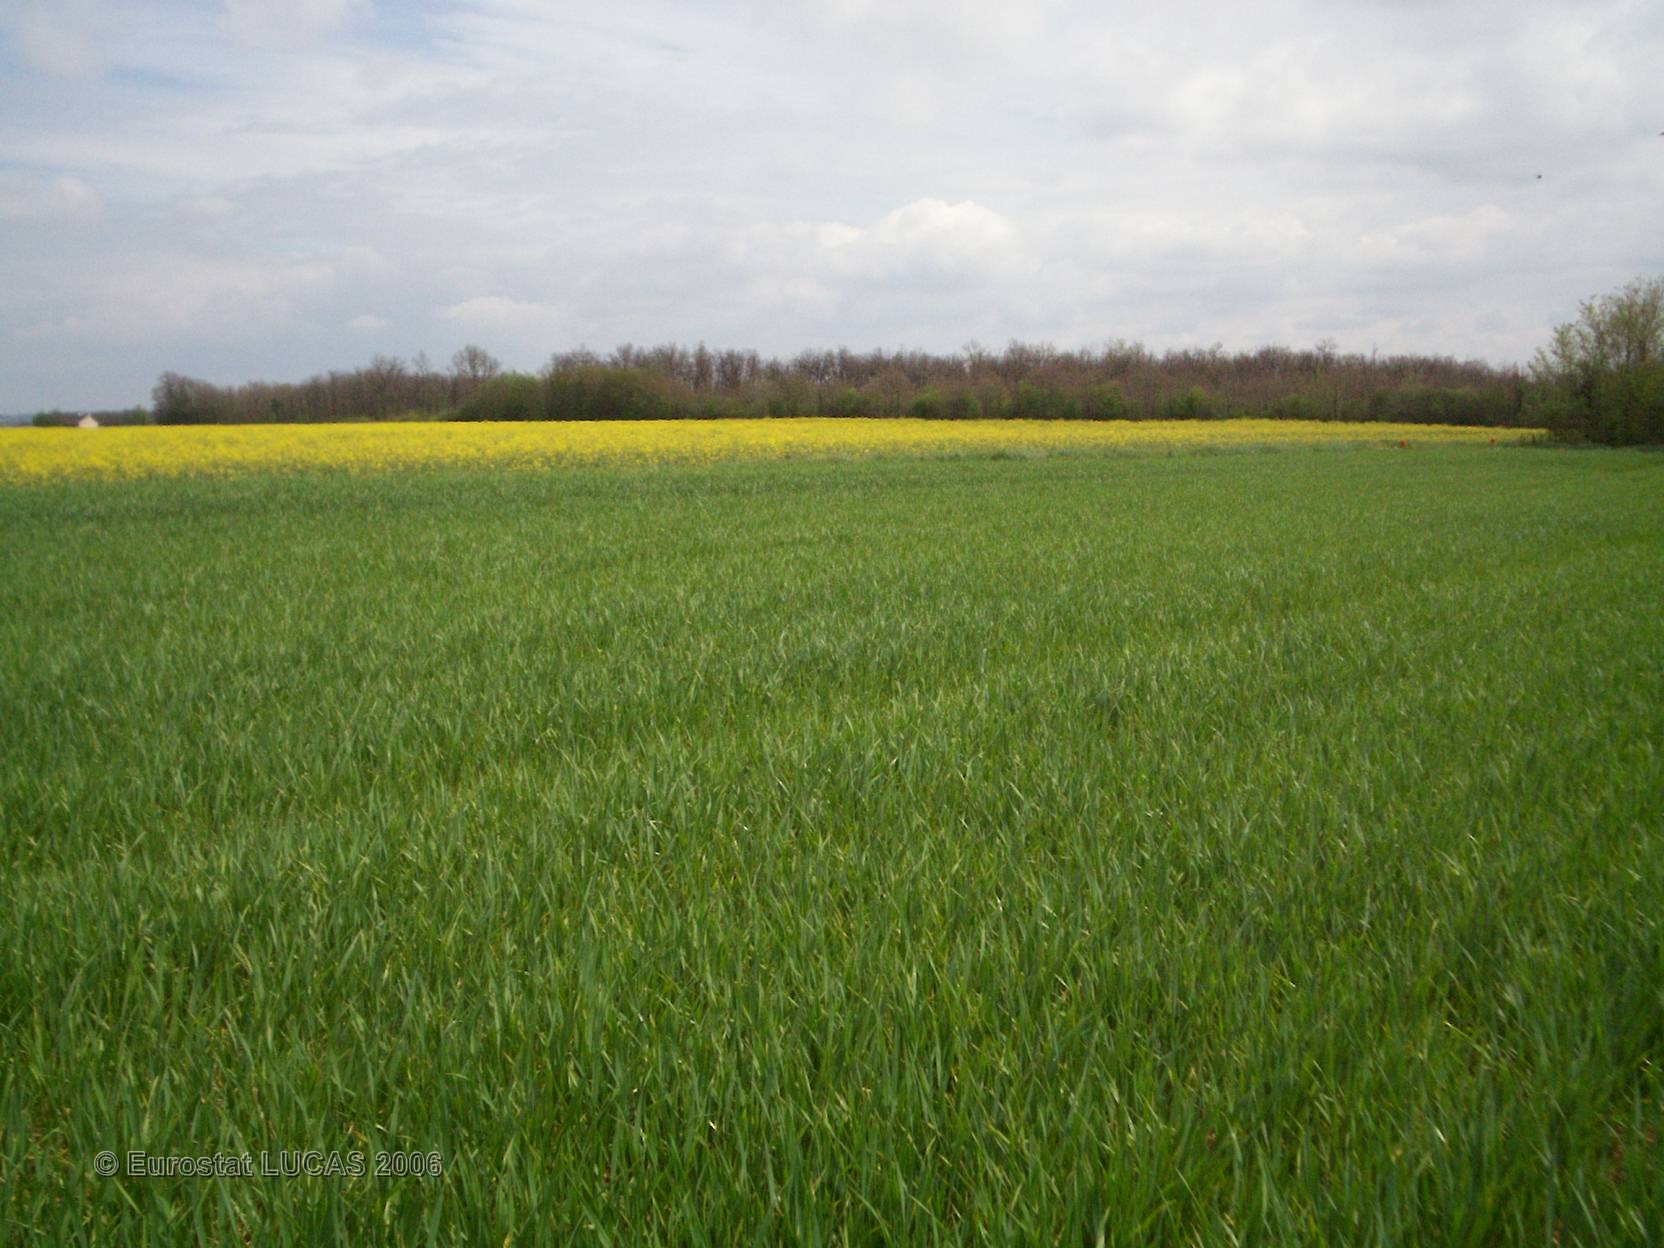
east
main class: Cropland
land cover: Barley
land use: Agriculture (excluding fallow land and kitchen gardens)
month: April
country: FR
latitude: 47.0449
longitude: 0.2248
